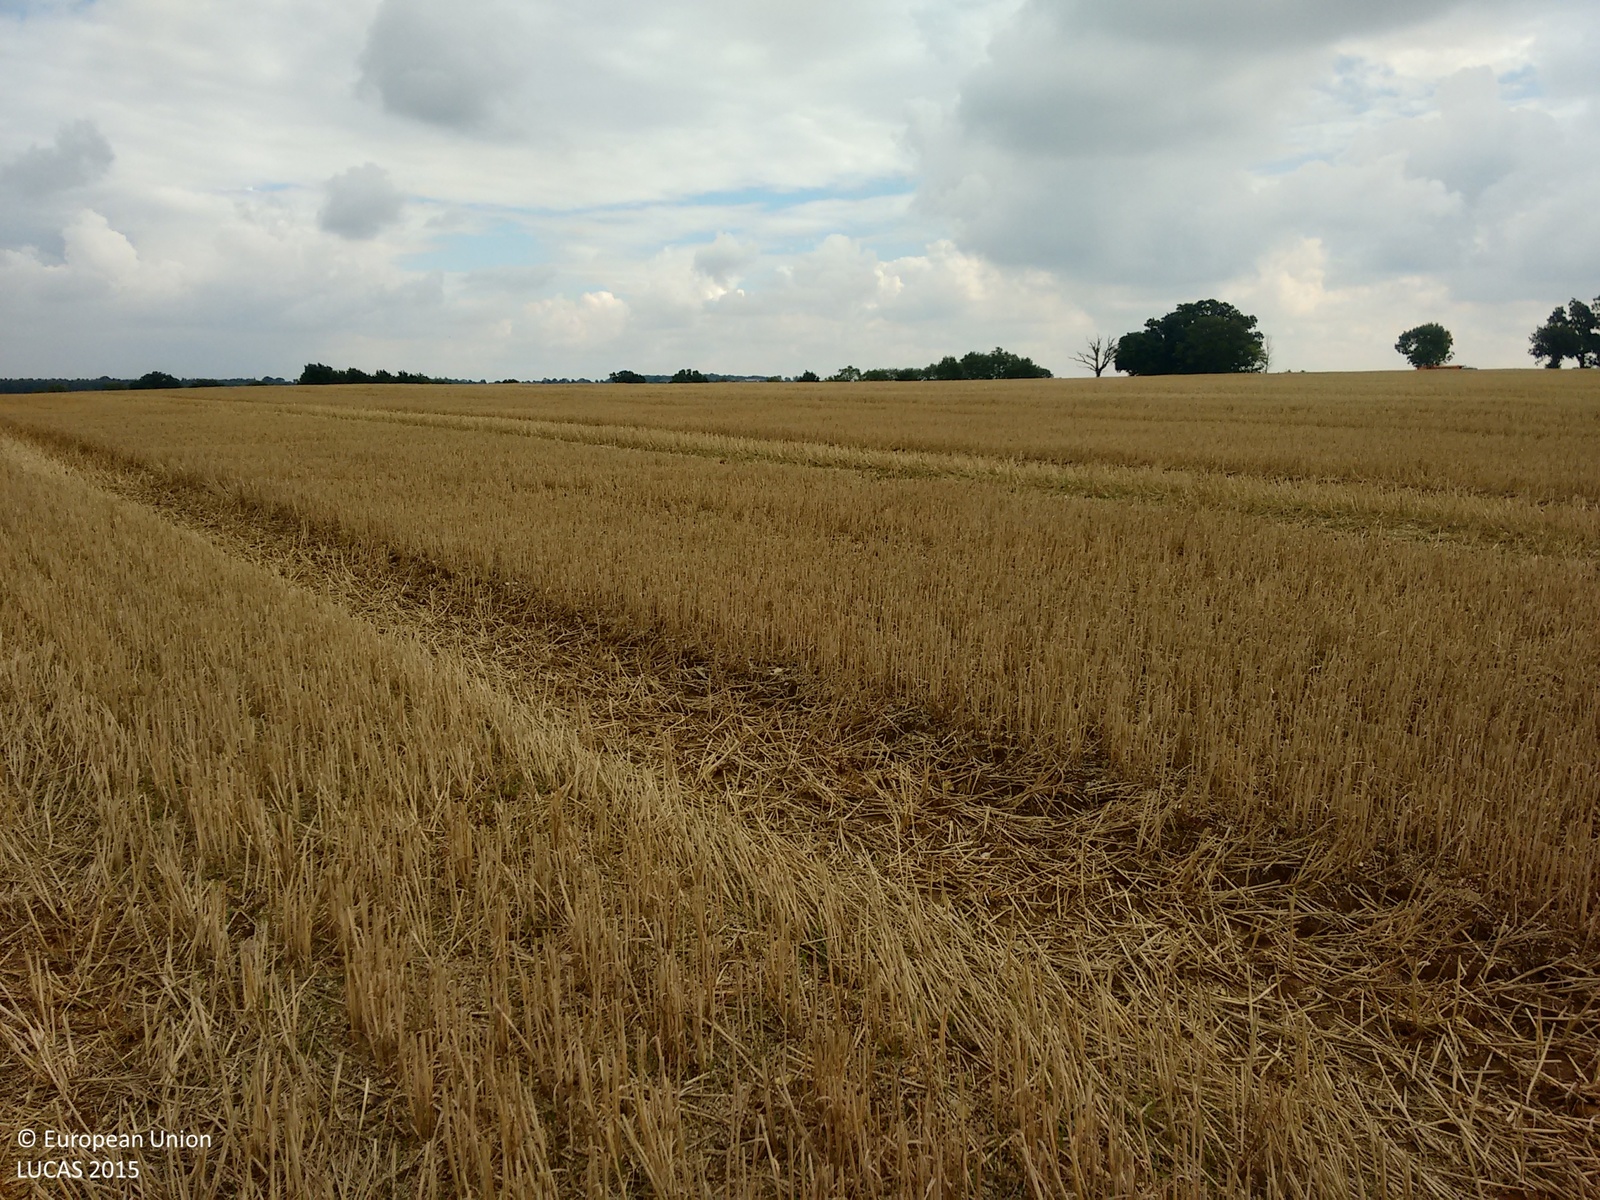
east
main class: Cropland
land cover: Common wheat
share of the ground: > 75 %
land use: Agriculture (excluding fallow land and kitchen gardens)
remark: Harvested field
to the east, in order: Common wheat
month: September
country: GB
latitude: 52.2512
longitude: 0.5246
